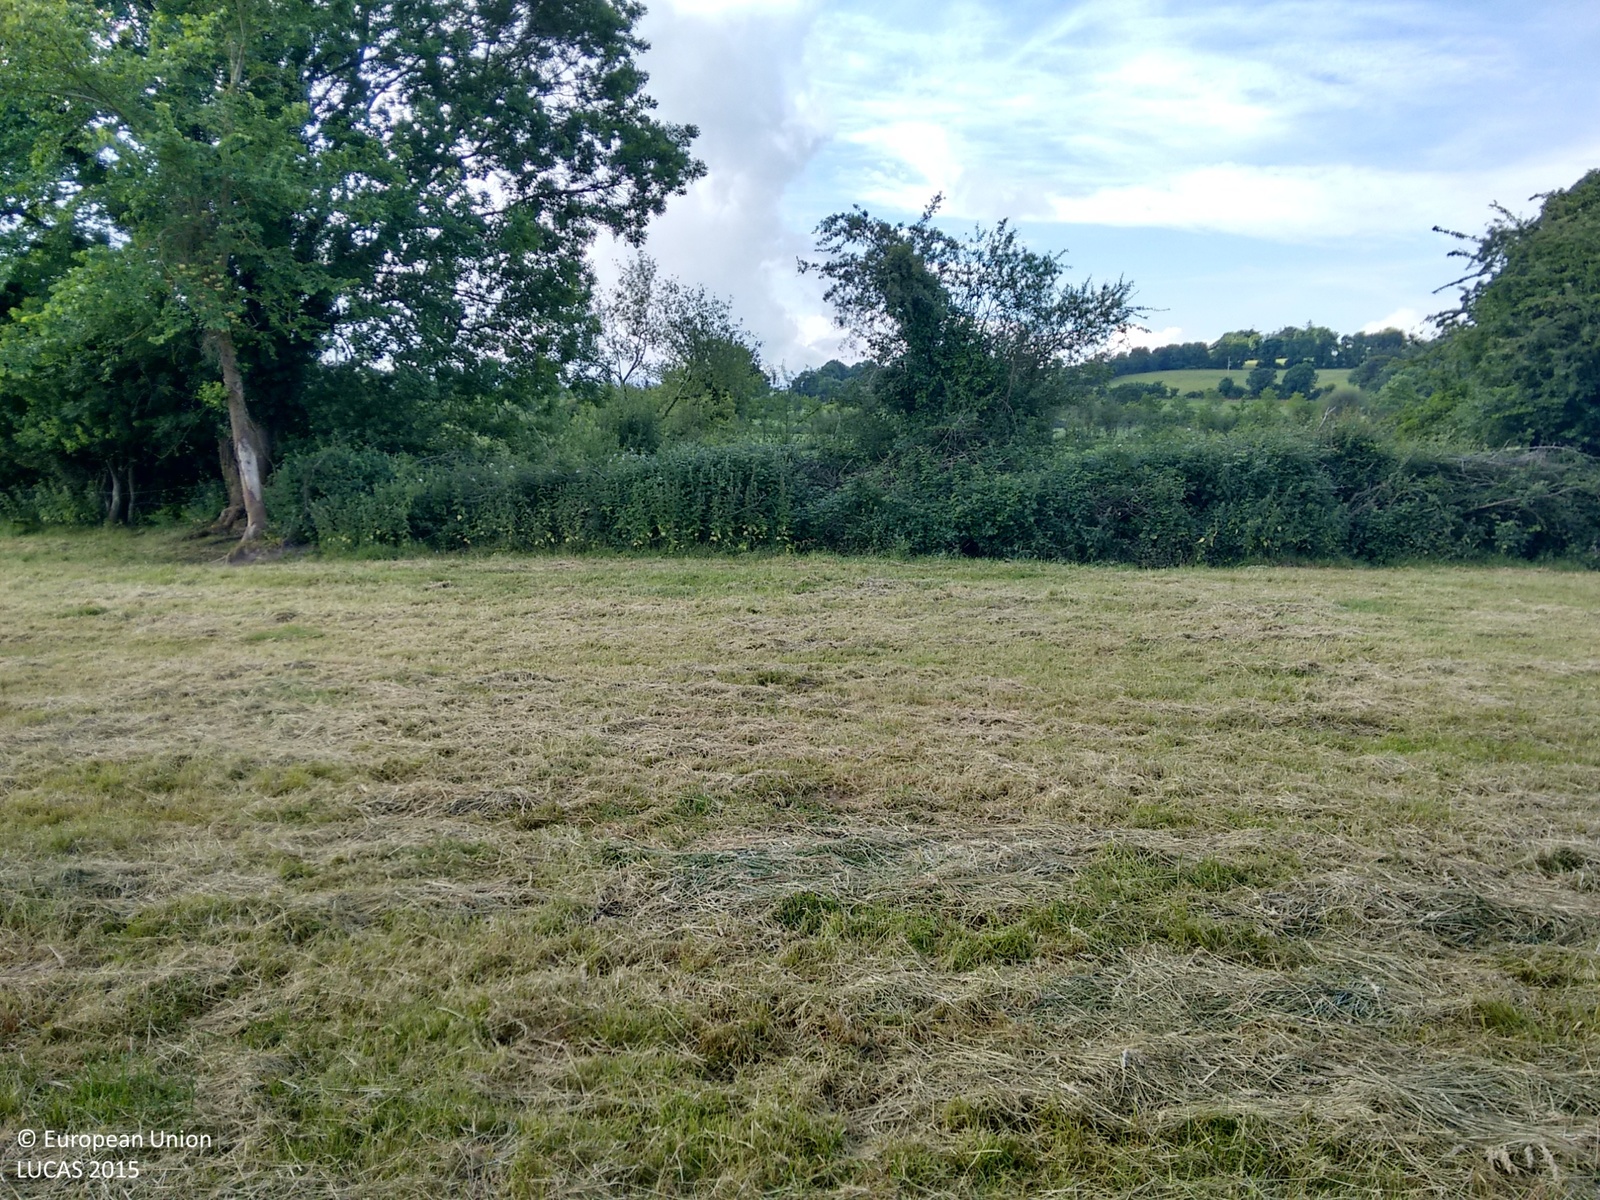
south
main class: Grassland
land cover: Grassland with sparse tree/shrub cover
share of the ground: > 75 %
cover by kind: herbaceous plants 95 %, broadleaved forest trees 5 %
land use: Residential
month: July
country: IE
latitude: 52.5218
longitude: -7.5974
